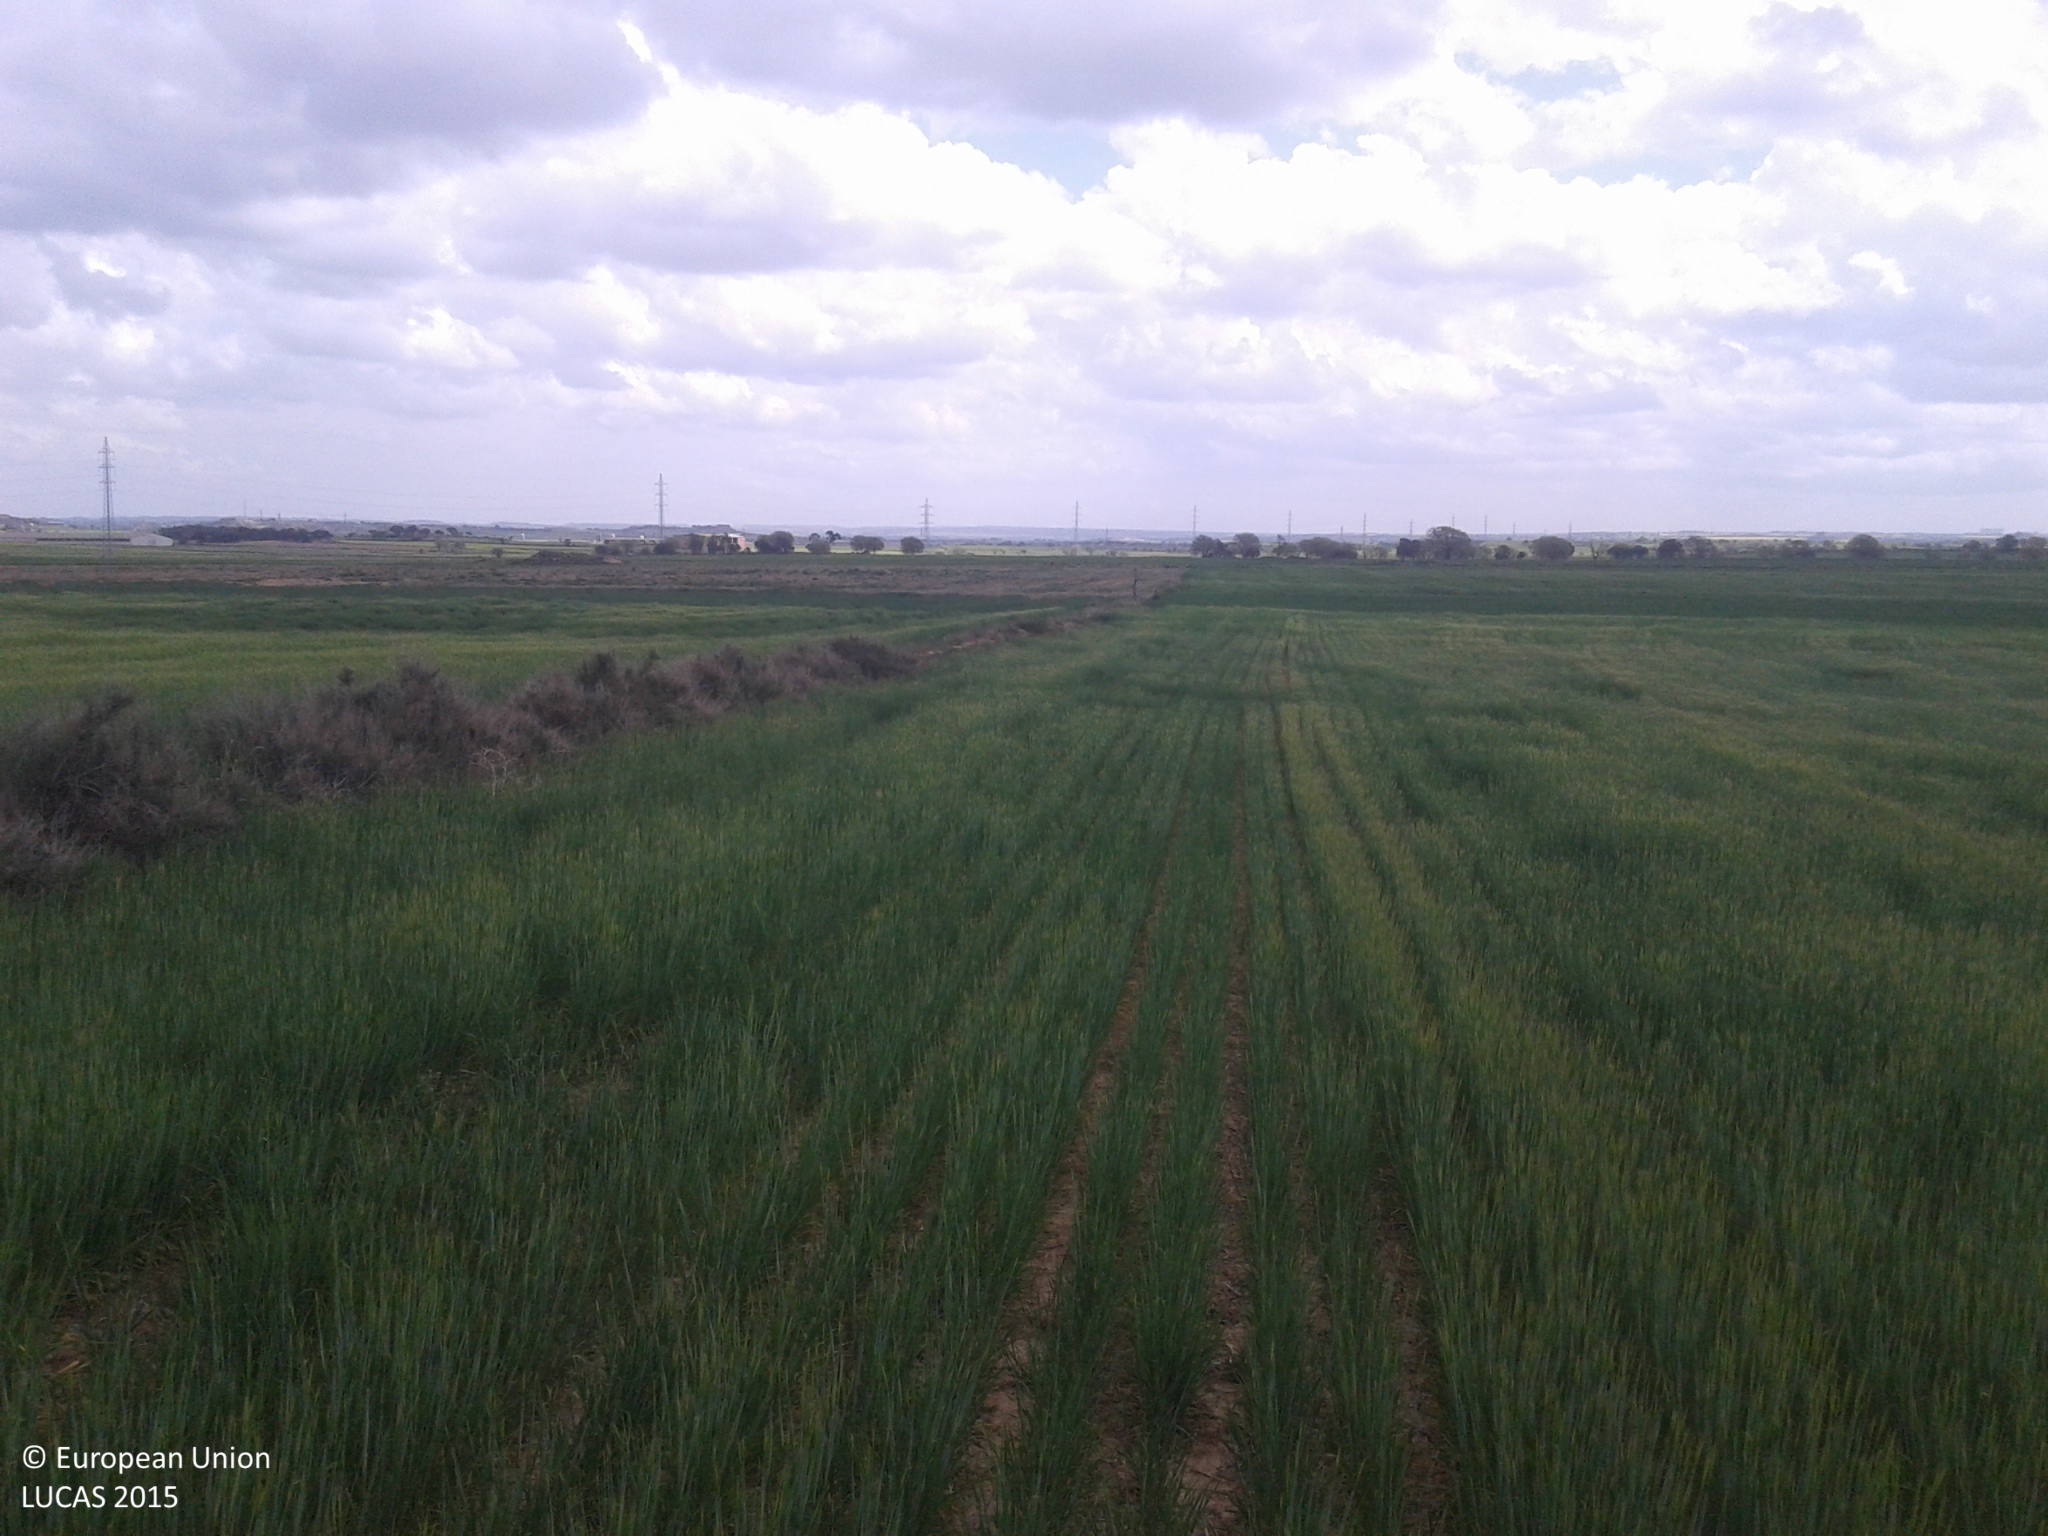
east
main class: Cropland
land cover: Barley
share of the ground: > 75 %
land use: Agriculture (excluding fallow land and kitchen gardens)
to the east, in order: Barley; Grass margins; Barley; Spontaneously vegetated surfaces; Barley
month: April
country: ES
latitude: 41.7394
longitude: 1.1514
